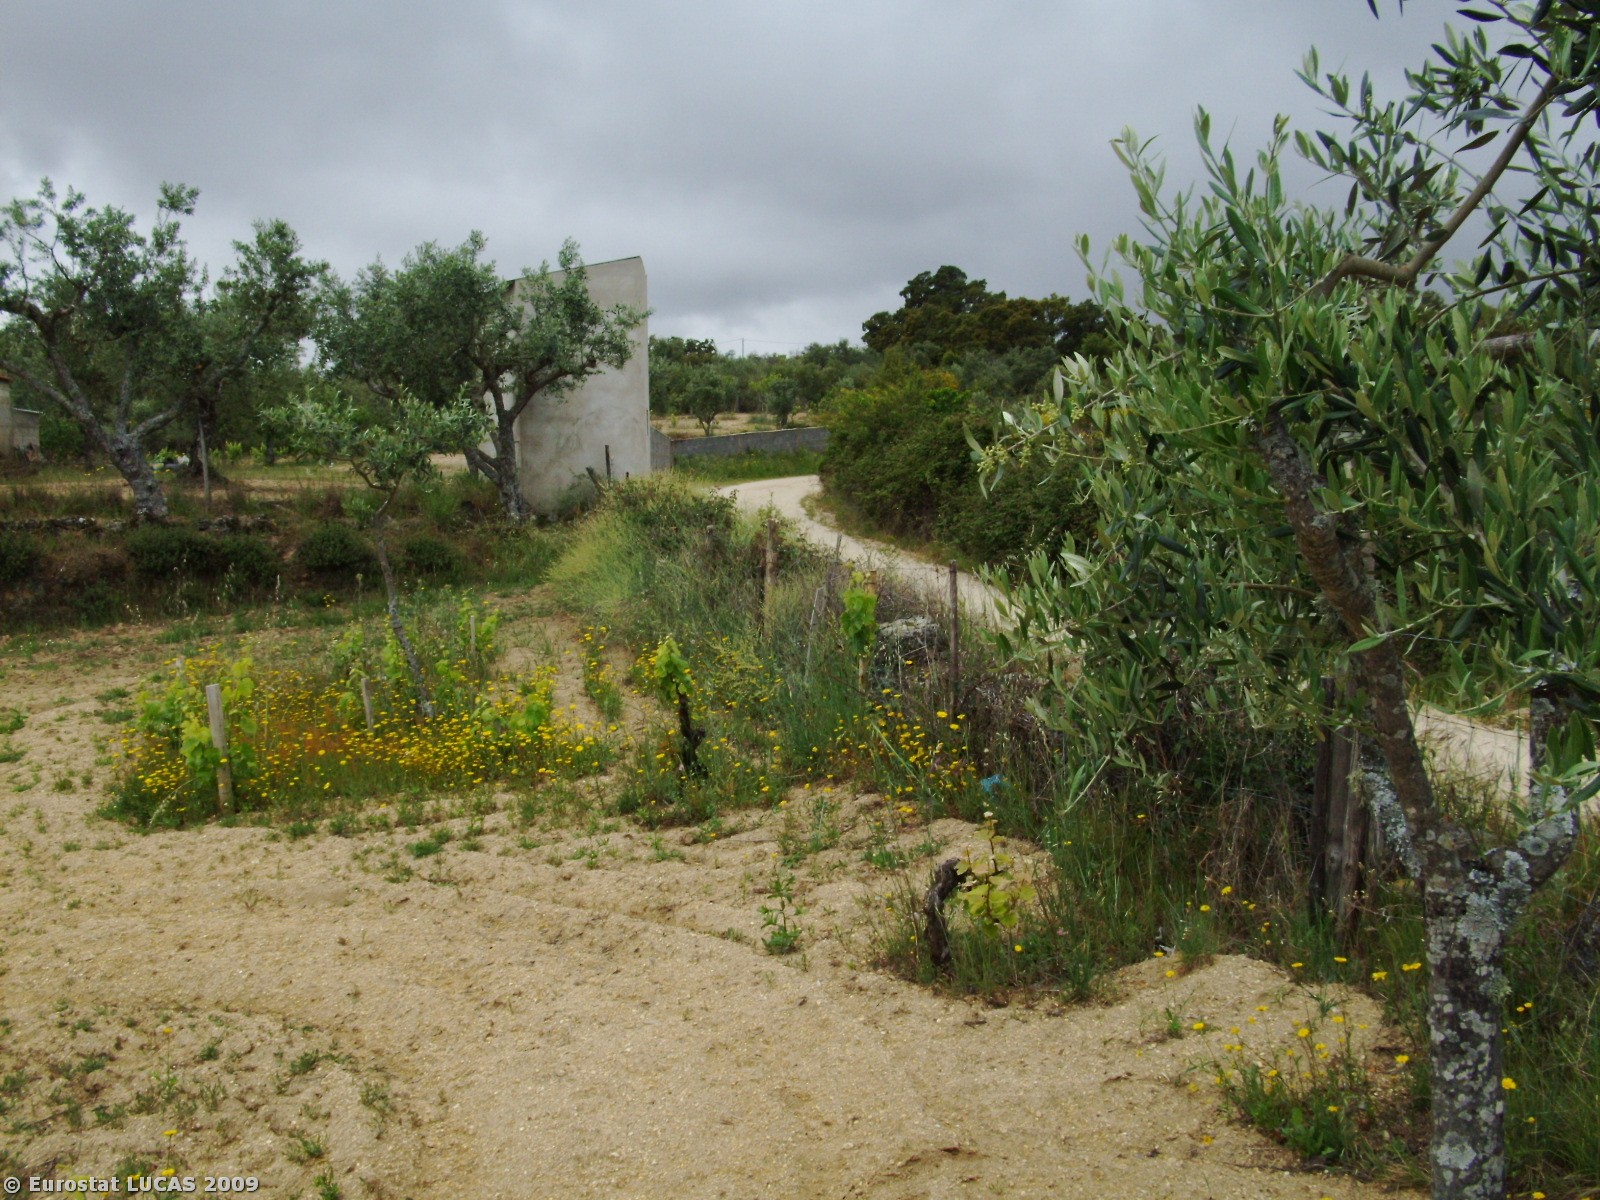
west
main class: Cropland
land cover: Vineyards
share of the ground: 10 - 25 %
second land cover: Bare land
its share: > 75 %
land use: Agriculture (excluding fallow land and kitchen gardens)
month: April
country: PT
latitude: 39.8702
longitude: -7.5563
